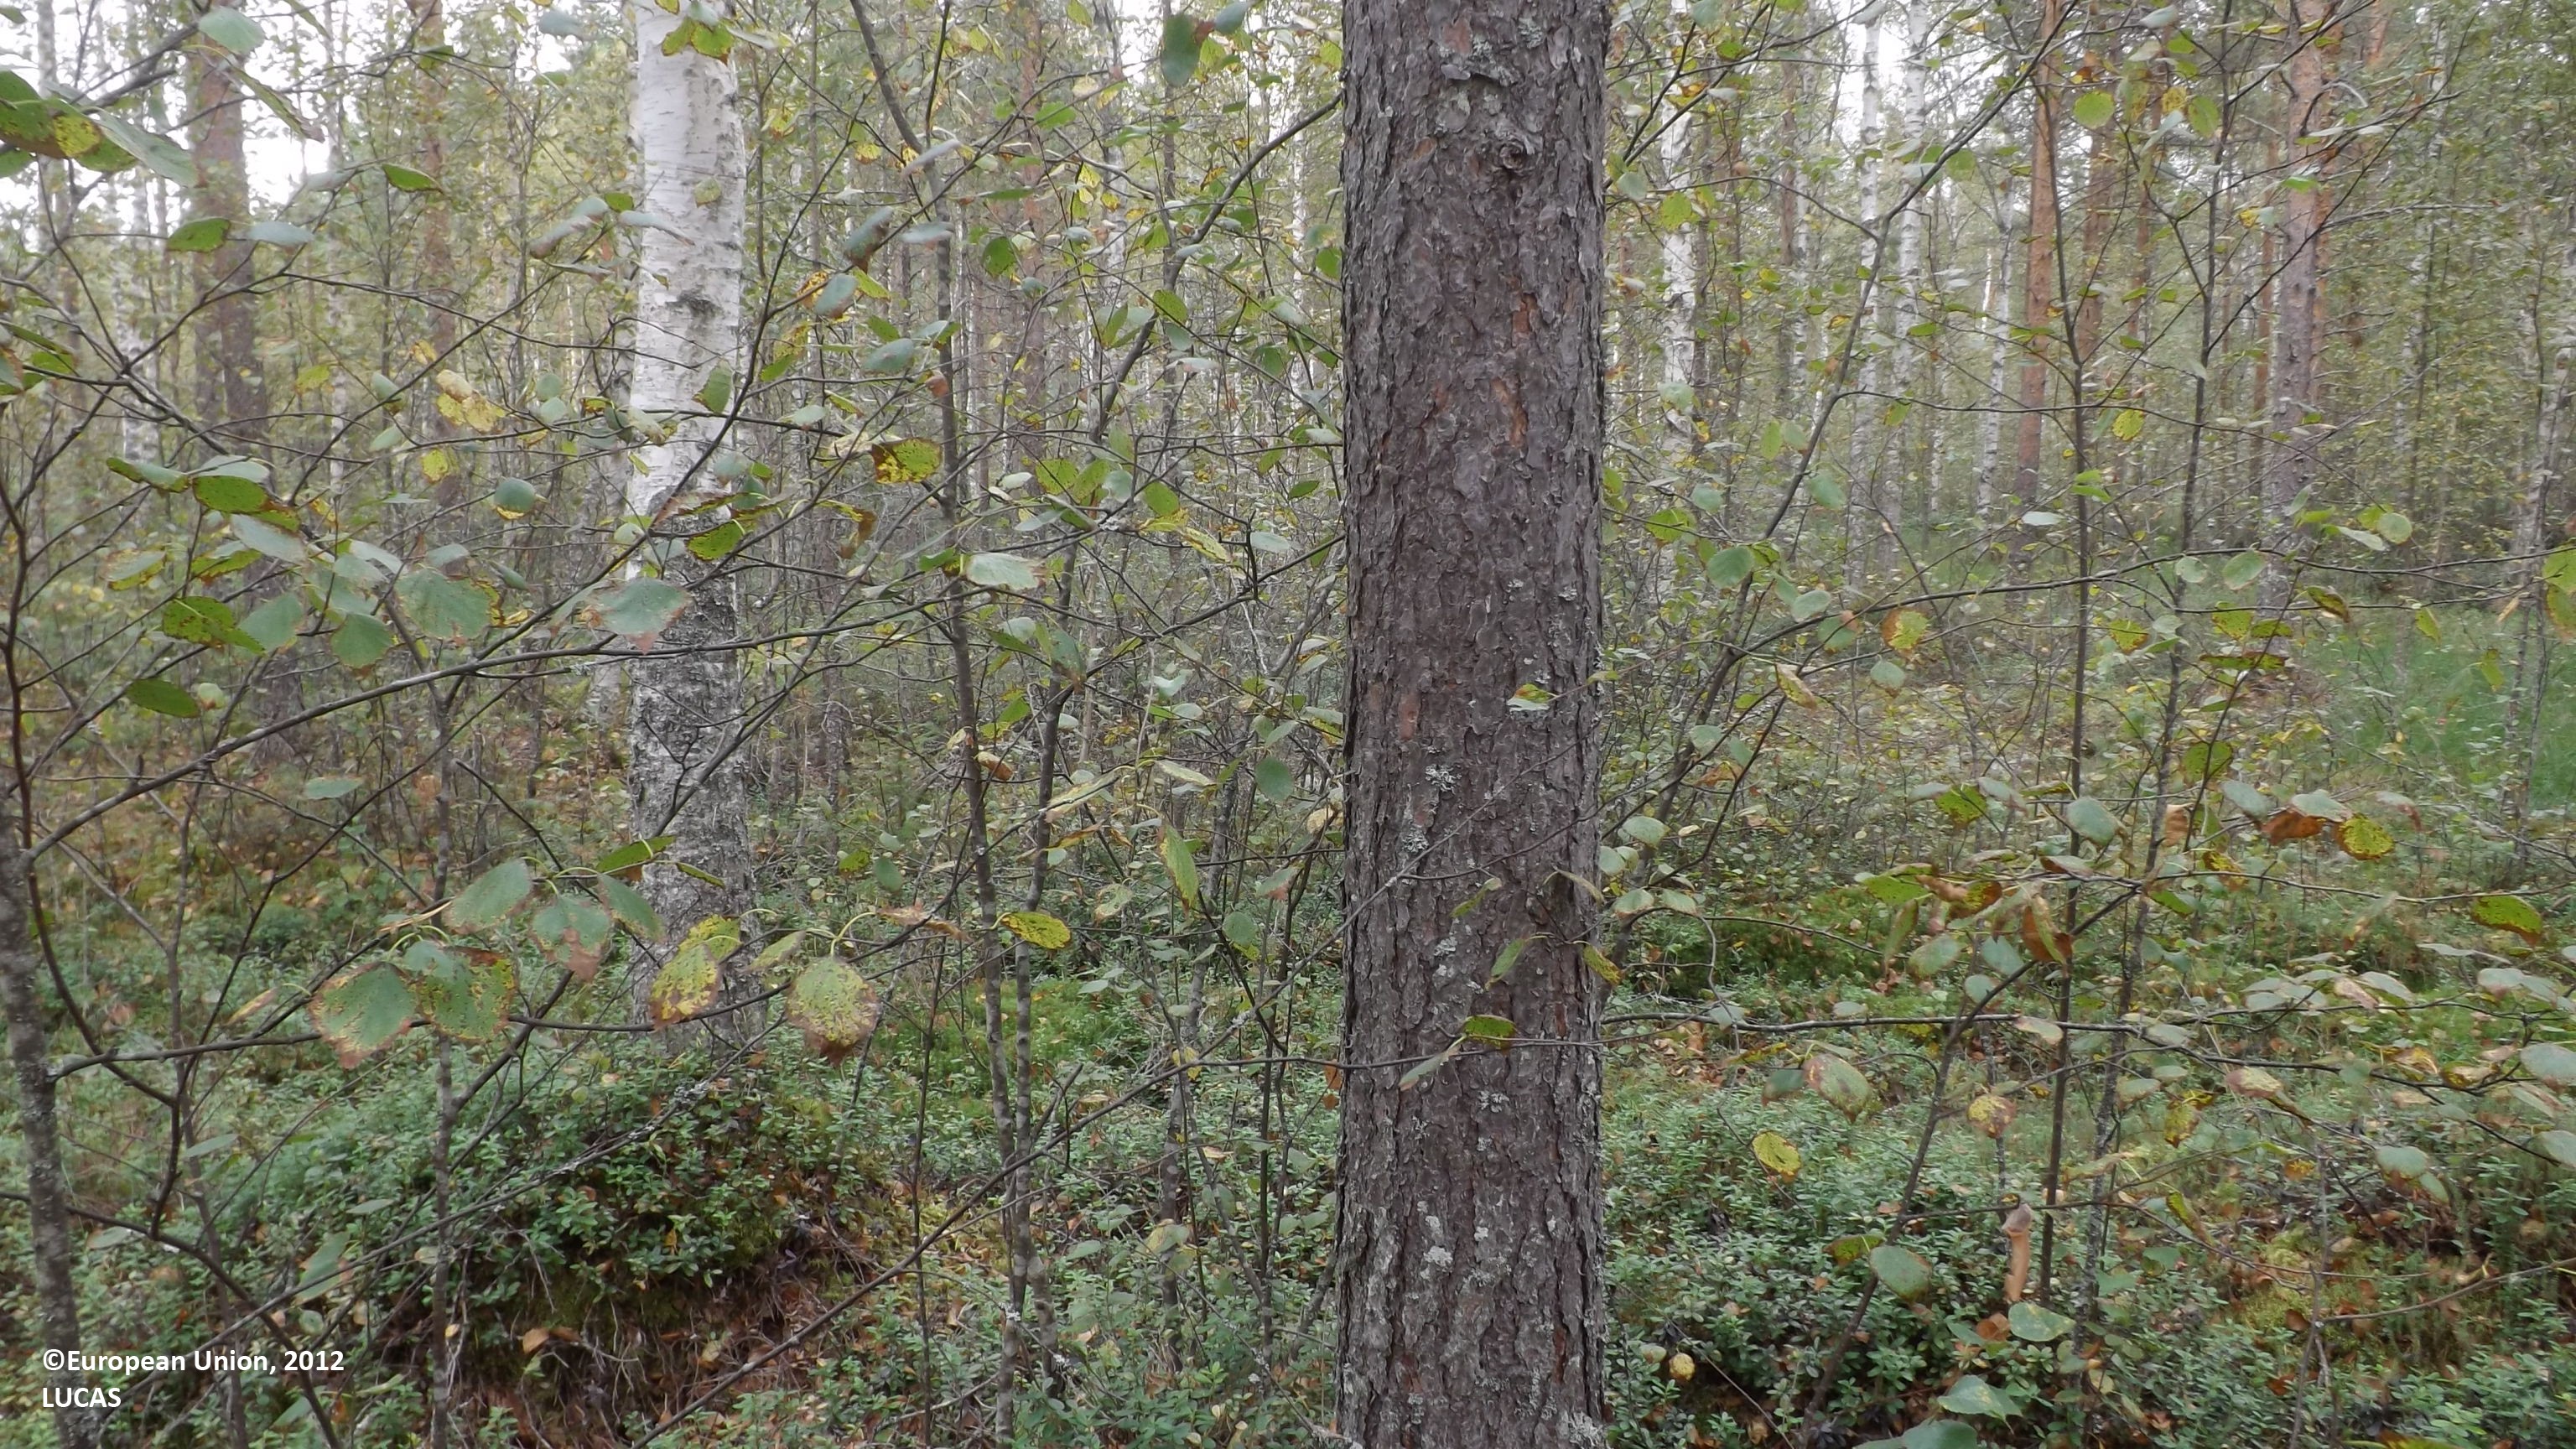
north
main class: Woodland
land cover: Pine dominated mixed woodland
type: boreal forest
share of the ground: > 75 %
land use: Forestry
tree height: > 5 m
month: August
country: FI
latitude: 63.8758
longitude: 23.8861
